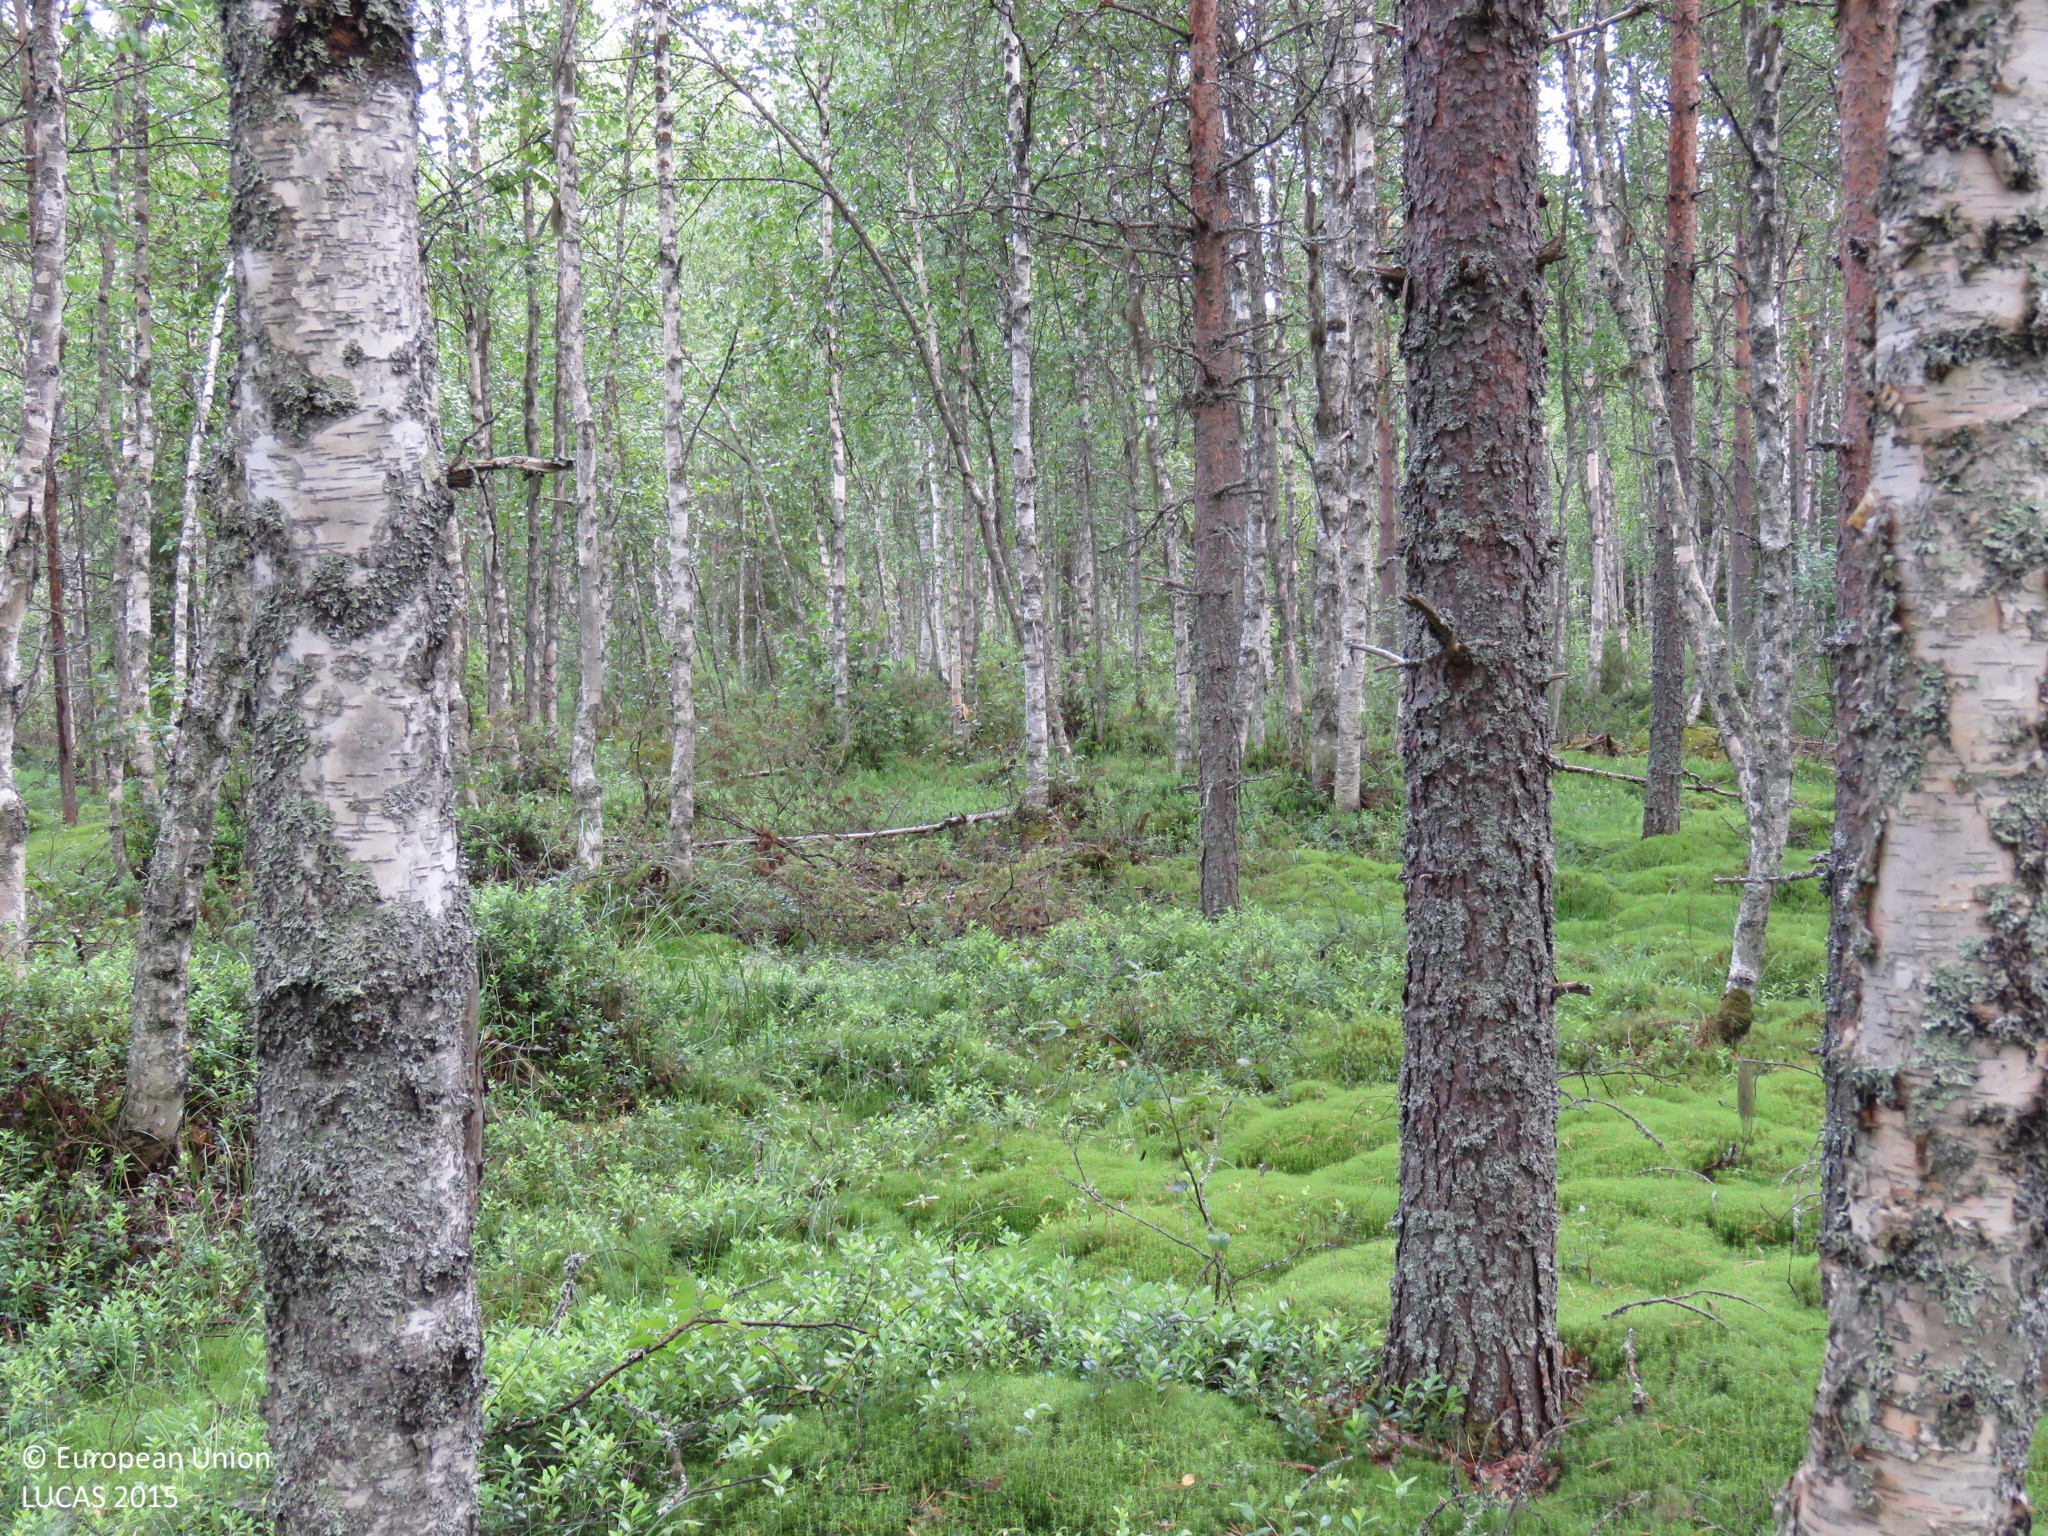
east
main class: Woodland
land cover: Broadleaved woodland
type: non-riverine alder, birch or aspen forest
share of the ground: > 75 %
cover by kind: broadleaved forest trees 65 %, coniferous forest trees 20 %, lichens and mosses 10 %, shrubs 5 %
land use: Forestry
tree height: > 5 m
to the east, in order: Broadleaved woodland; Other mixed woodland; Ditches and canals; Other mixed woodland; Ditches and canals; Other mixed woodland; Shruby margins; Ditches and canals; Other mixed woodland; Spruce dominated coniferous woodland; Other mixed woodland; Abandoned hedges; Ditches and canals; Grass margins; Barley
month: July
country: FI
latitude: 64.4818
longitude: 26.5732
